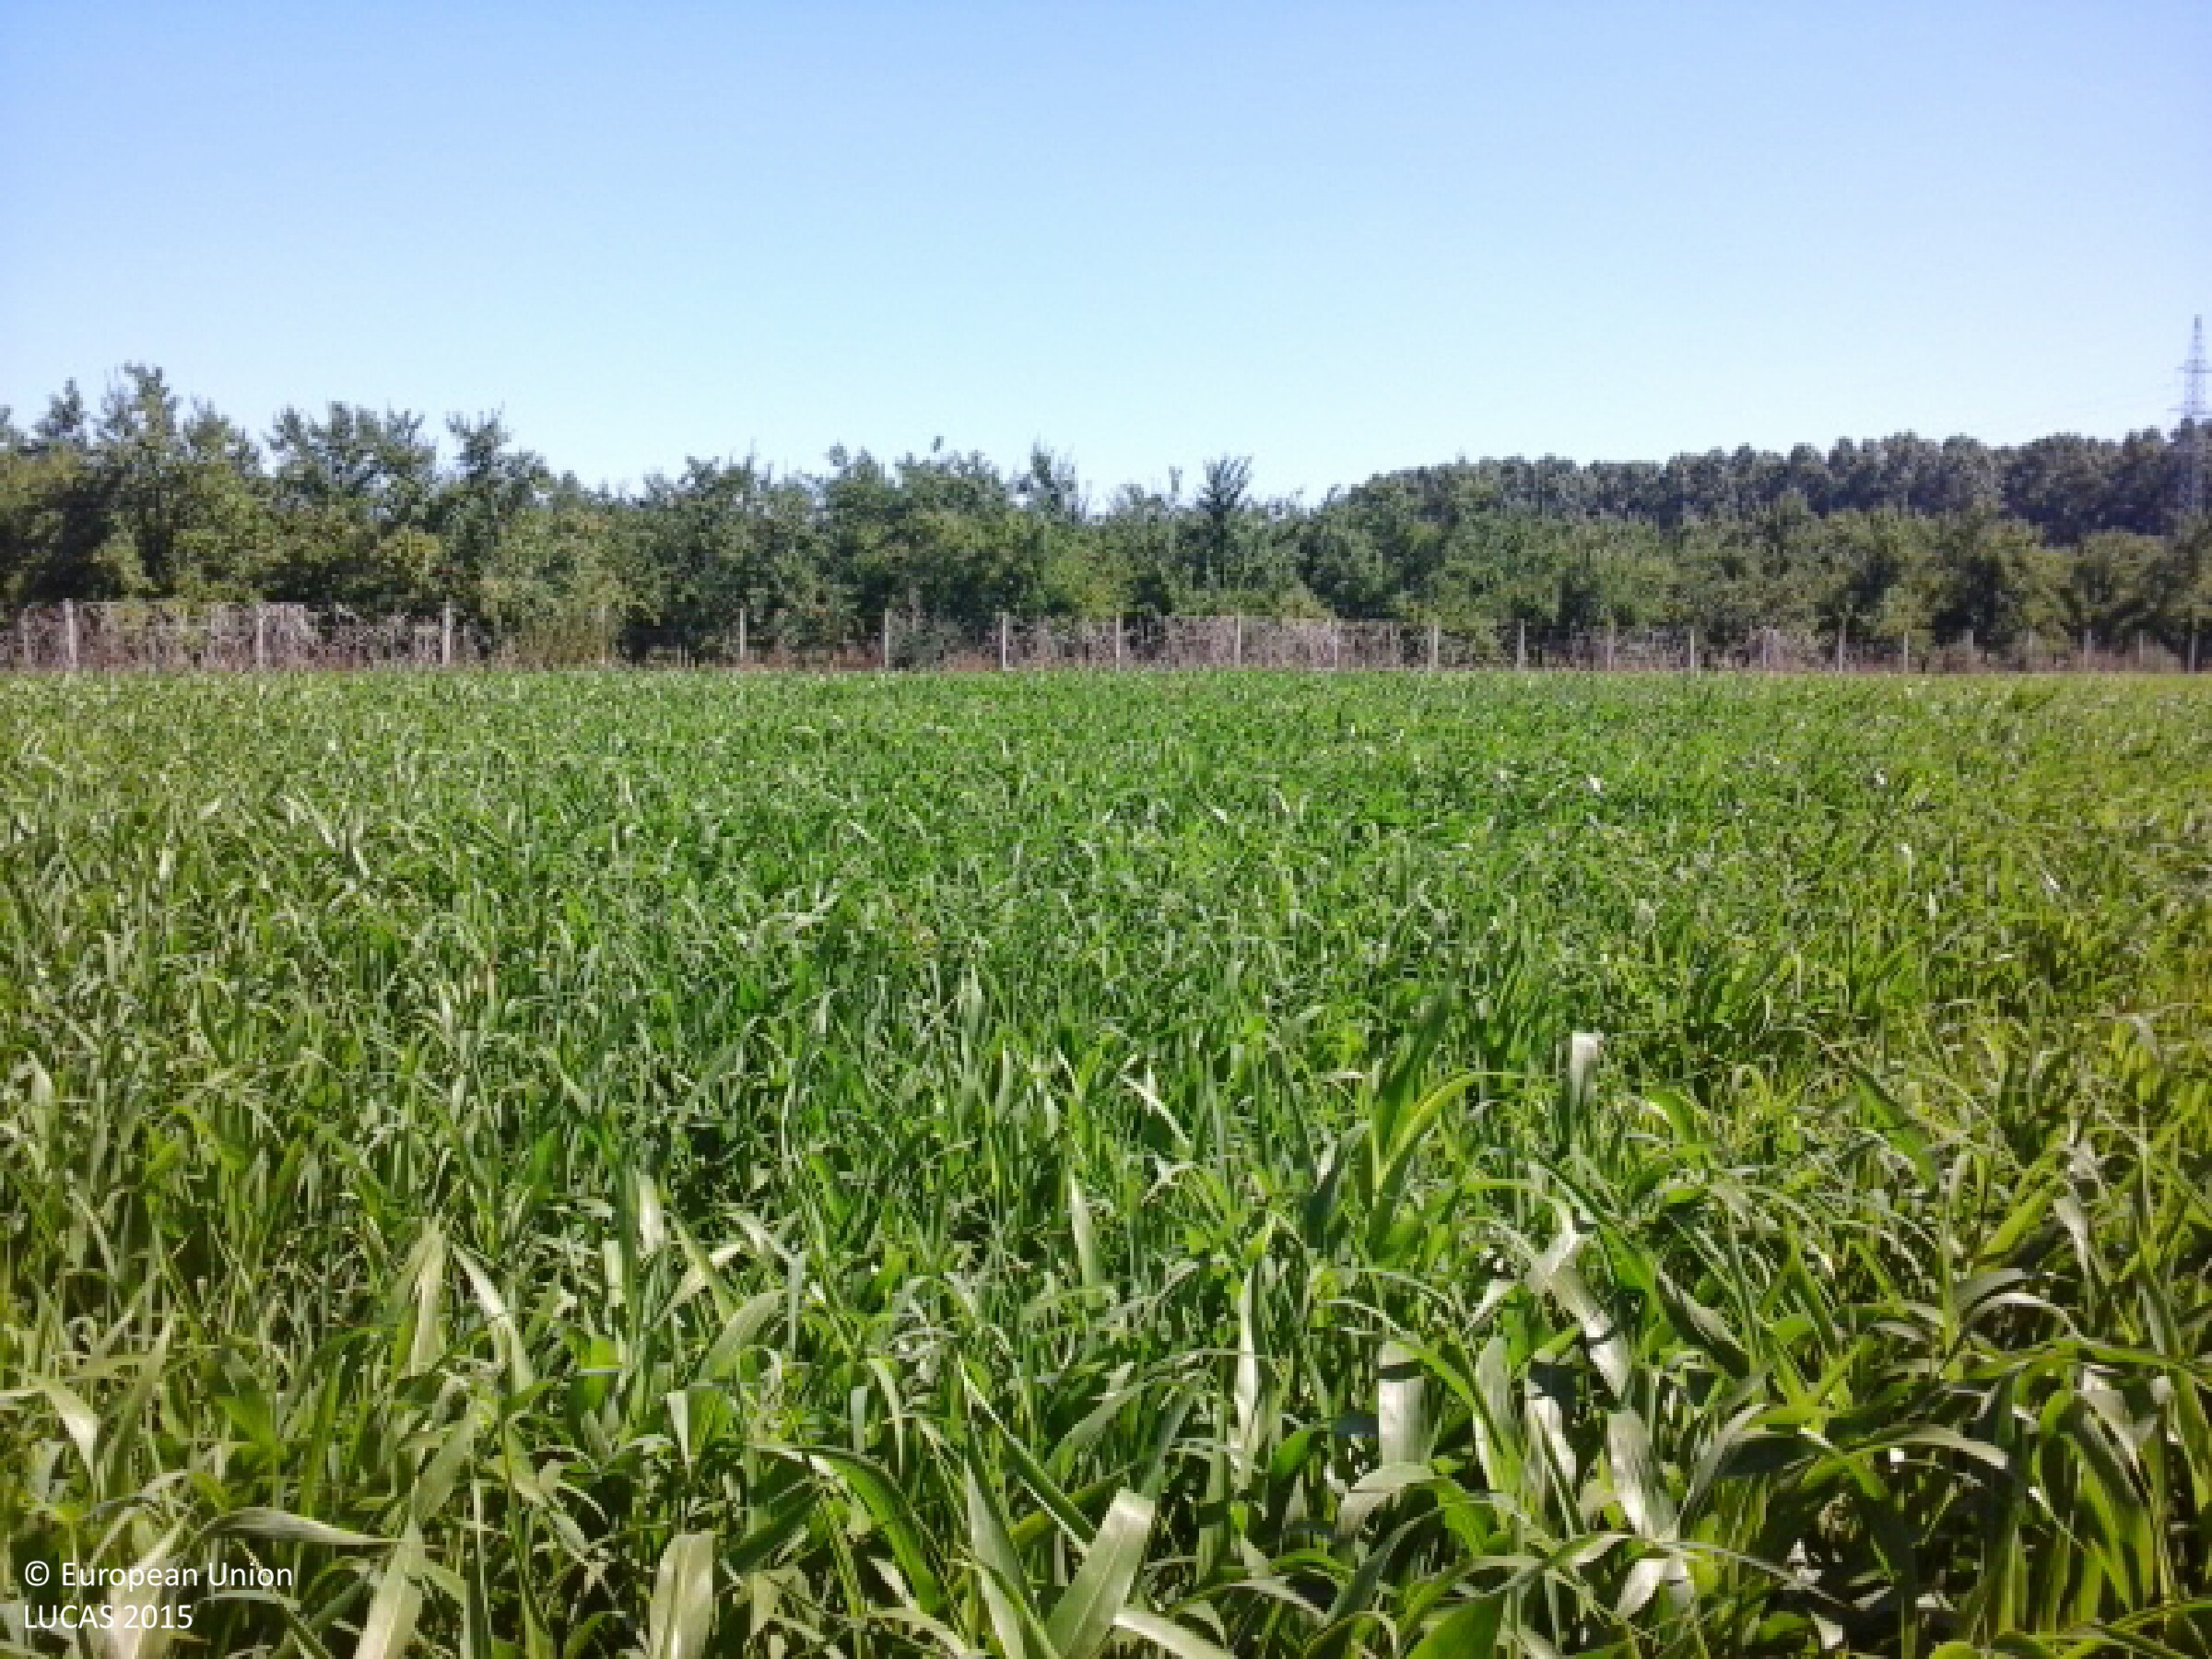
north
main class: Cropland
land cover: Maize
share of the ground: > 75 %
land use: Agriculture (excluding fallow land and kitchen gardens)
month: July
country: HU
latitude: 48.2329
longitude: 22.0494
